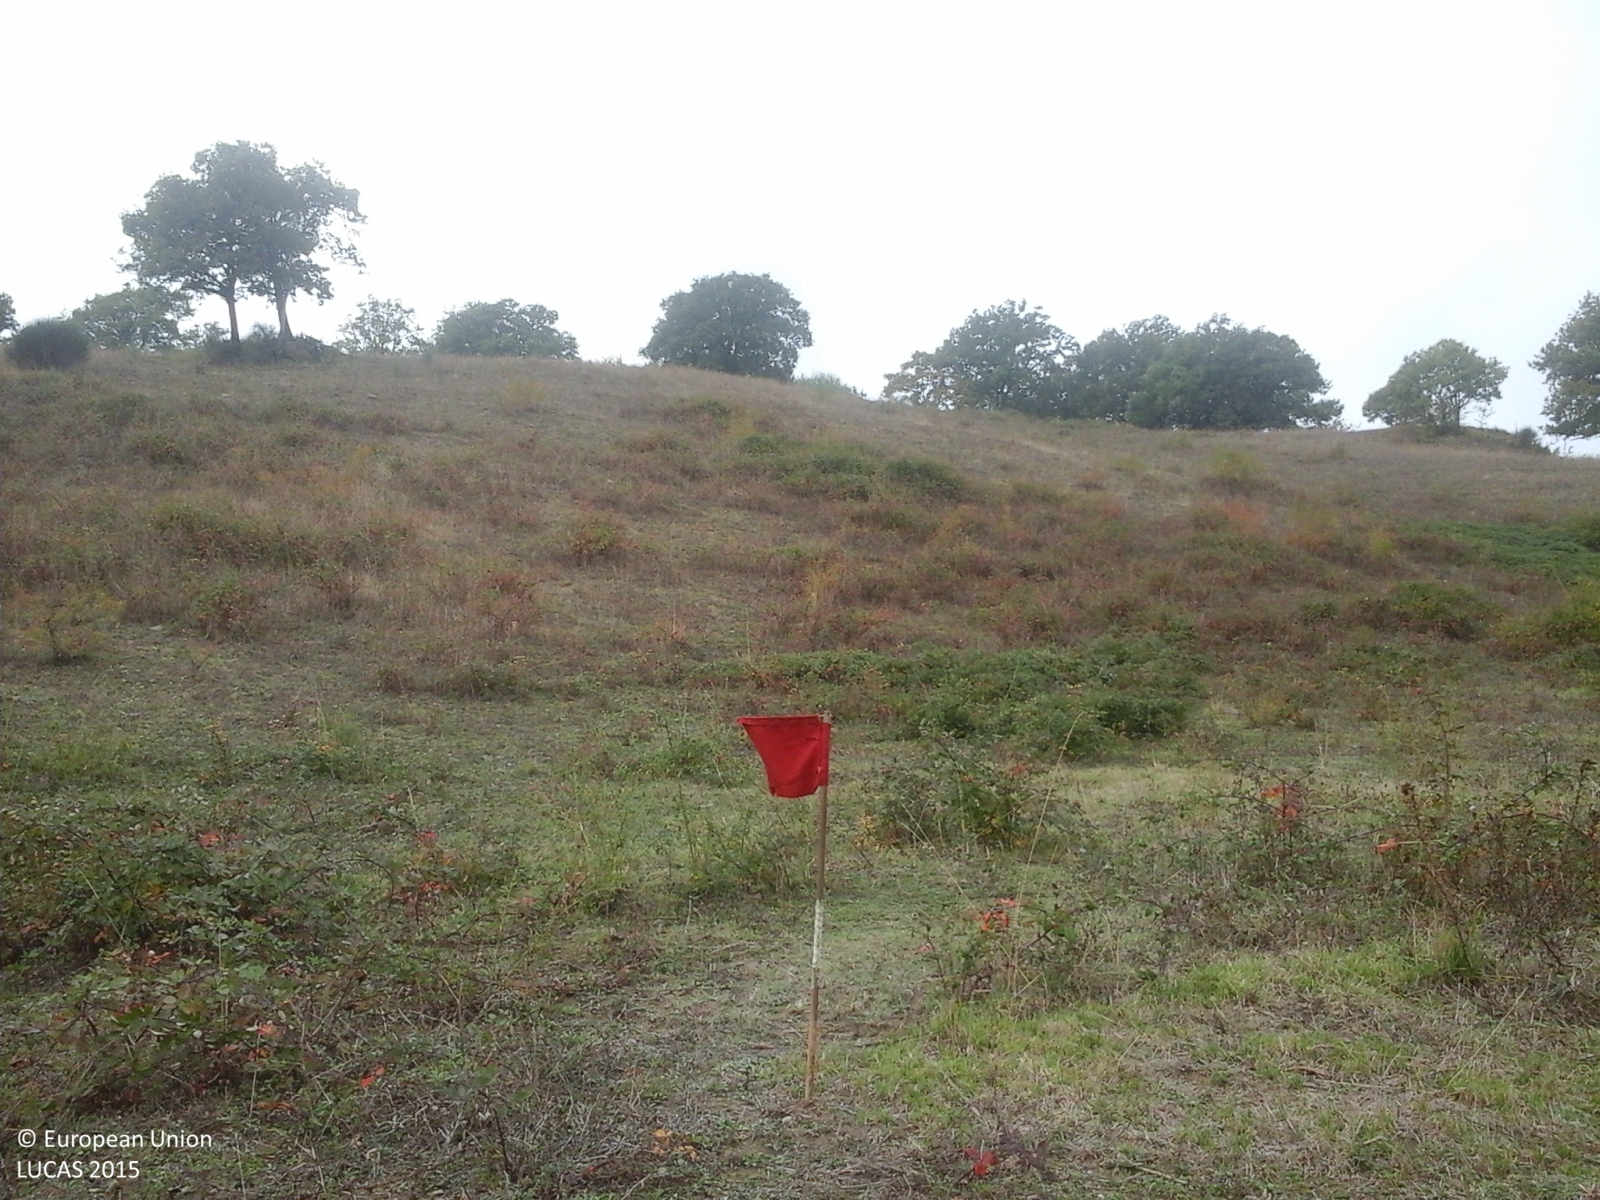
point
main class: Grassland
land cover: Grassland without tree/shrub cover
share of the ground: > 75 %
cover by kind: herbaceous plants 100 %
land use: Agriculture (excluding fallow land and kitchen gardens)
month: October
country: IT
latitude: 43.3656
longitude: 12.4244
